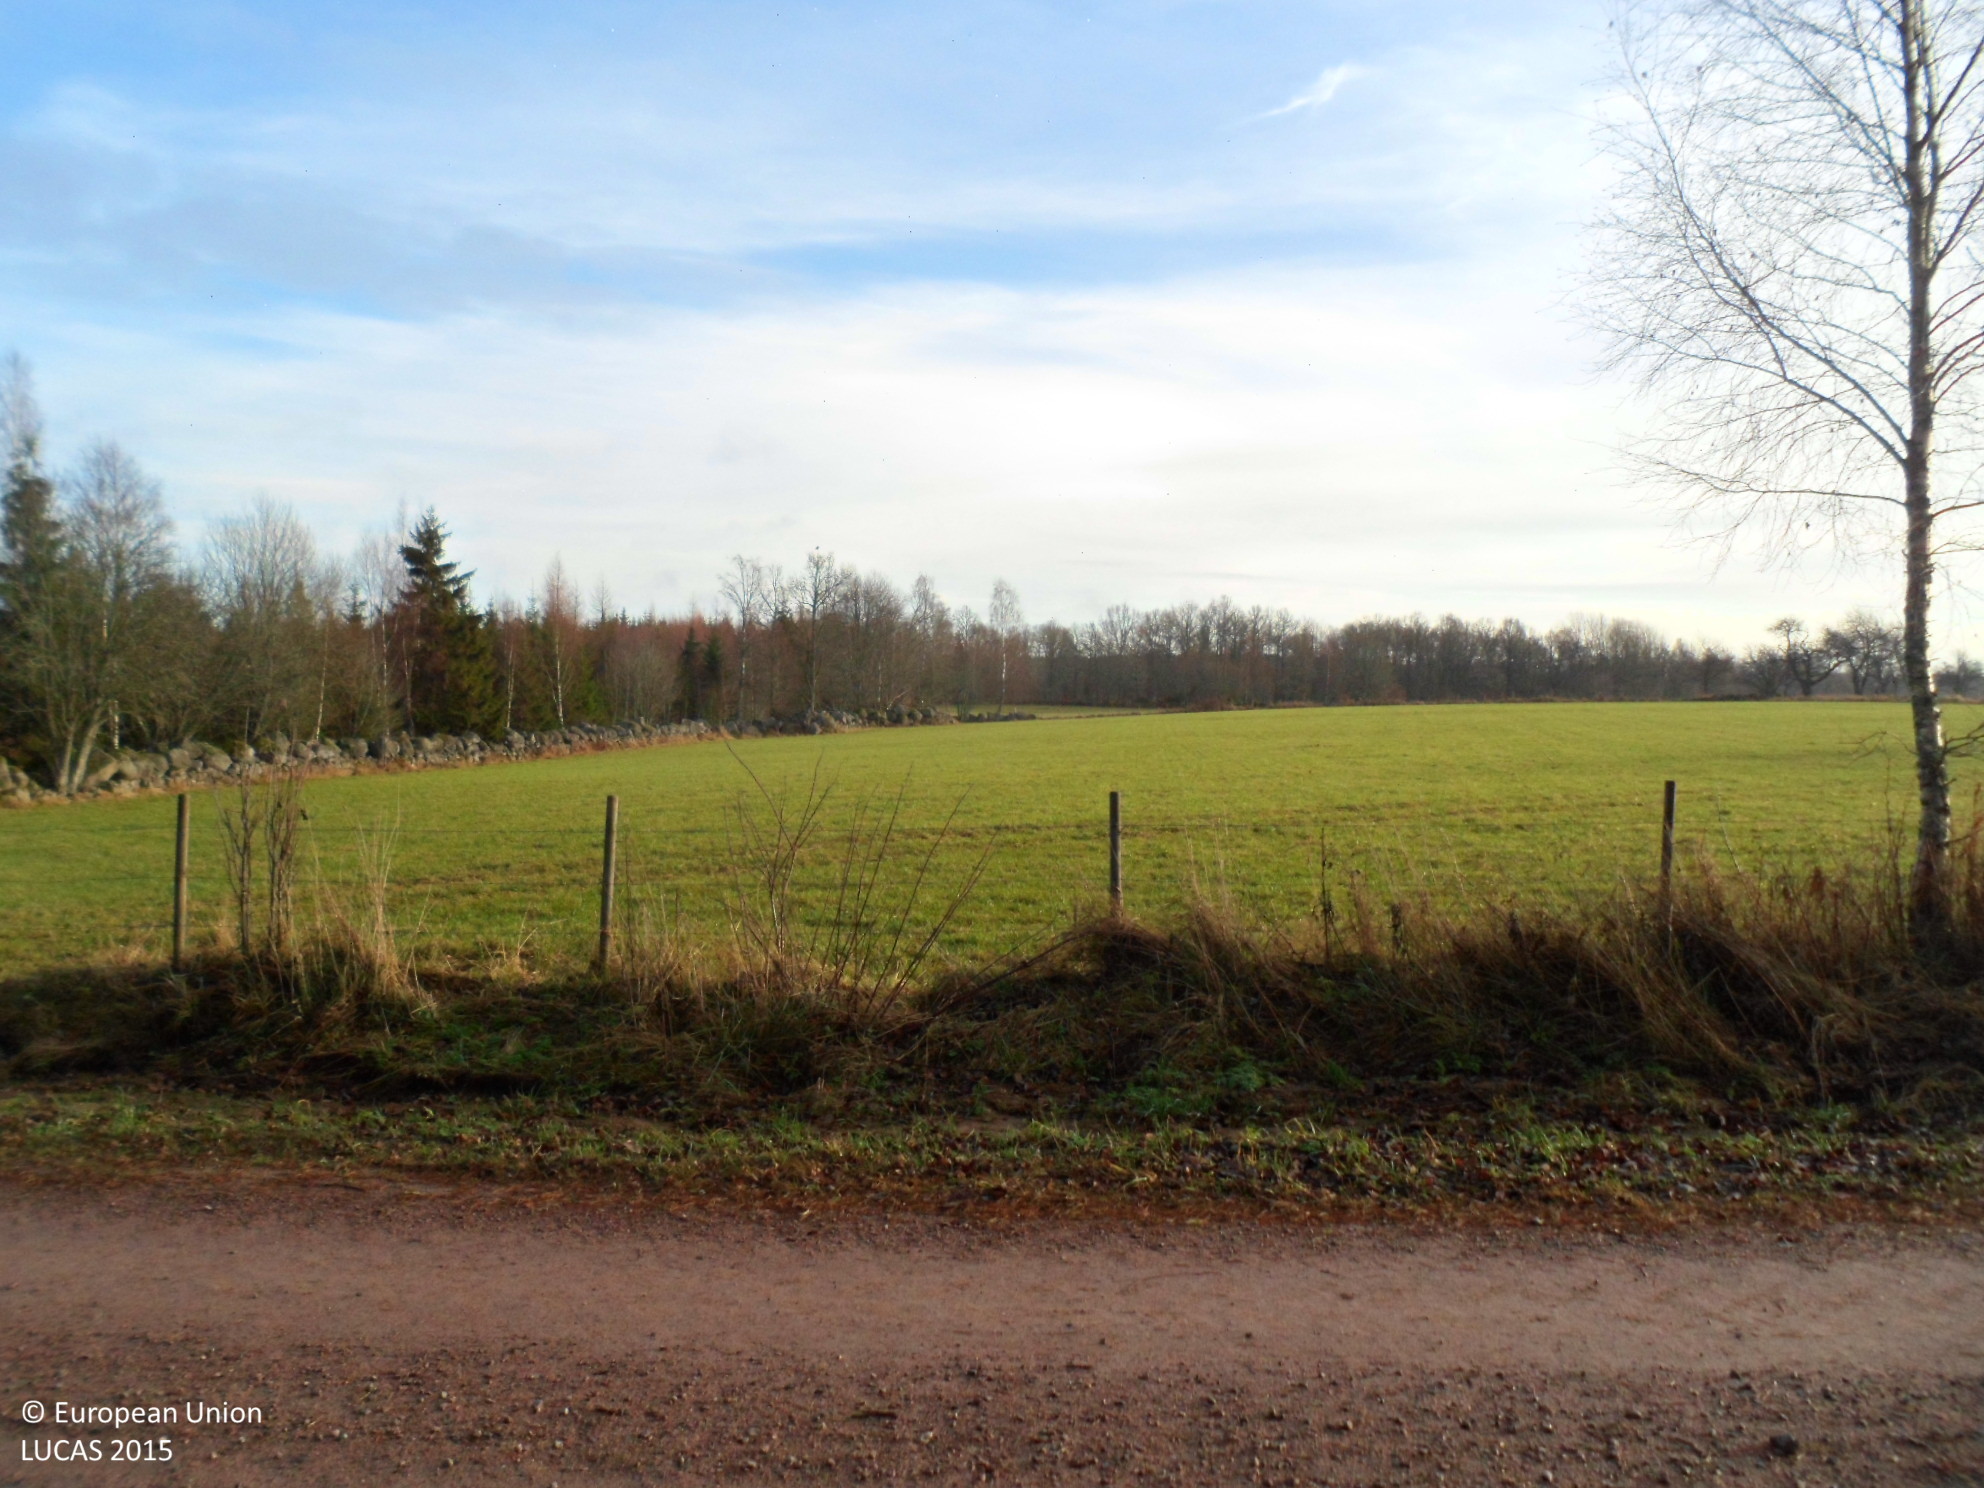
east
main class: Woodland
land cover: Broadleaved woodland
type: hemiboreal forest and nemoral coniferous forest and mixed broadleaved-coniferous forest
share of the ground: 10 - 25 %
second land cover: Grassland without tree/shrub cover
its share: > 75 %
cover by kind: herbaceous plants 55 %, broadleaved forest trees 20 %, shrubs 15 %, coniferous forest trees 5 %, lichens and mosses 5 %
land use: Forestry
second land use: Agriculture (excluding fallow land and kitchen gardens)
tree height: > 5 m
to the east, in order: Broadleaved woodland; Grassland without tree/shrub cover; Fences; Groves; Grass margins; Paved roads, cycling and walking lanes; Ditches and canals; Fences; Grassland without tree/shrub cover; Dry stone walls; Spruce dominated mixed woodland; Spruce dominated coniferous woodland
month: November
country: SE
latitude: 57.7468
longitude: 15.4900
